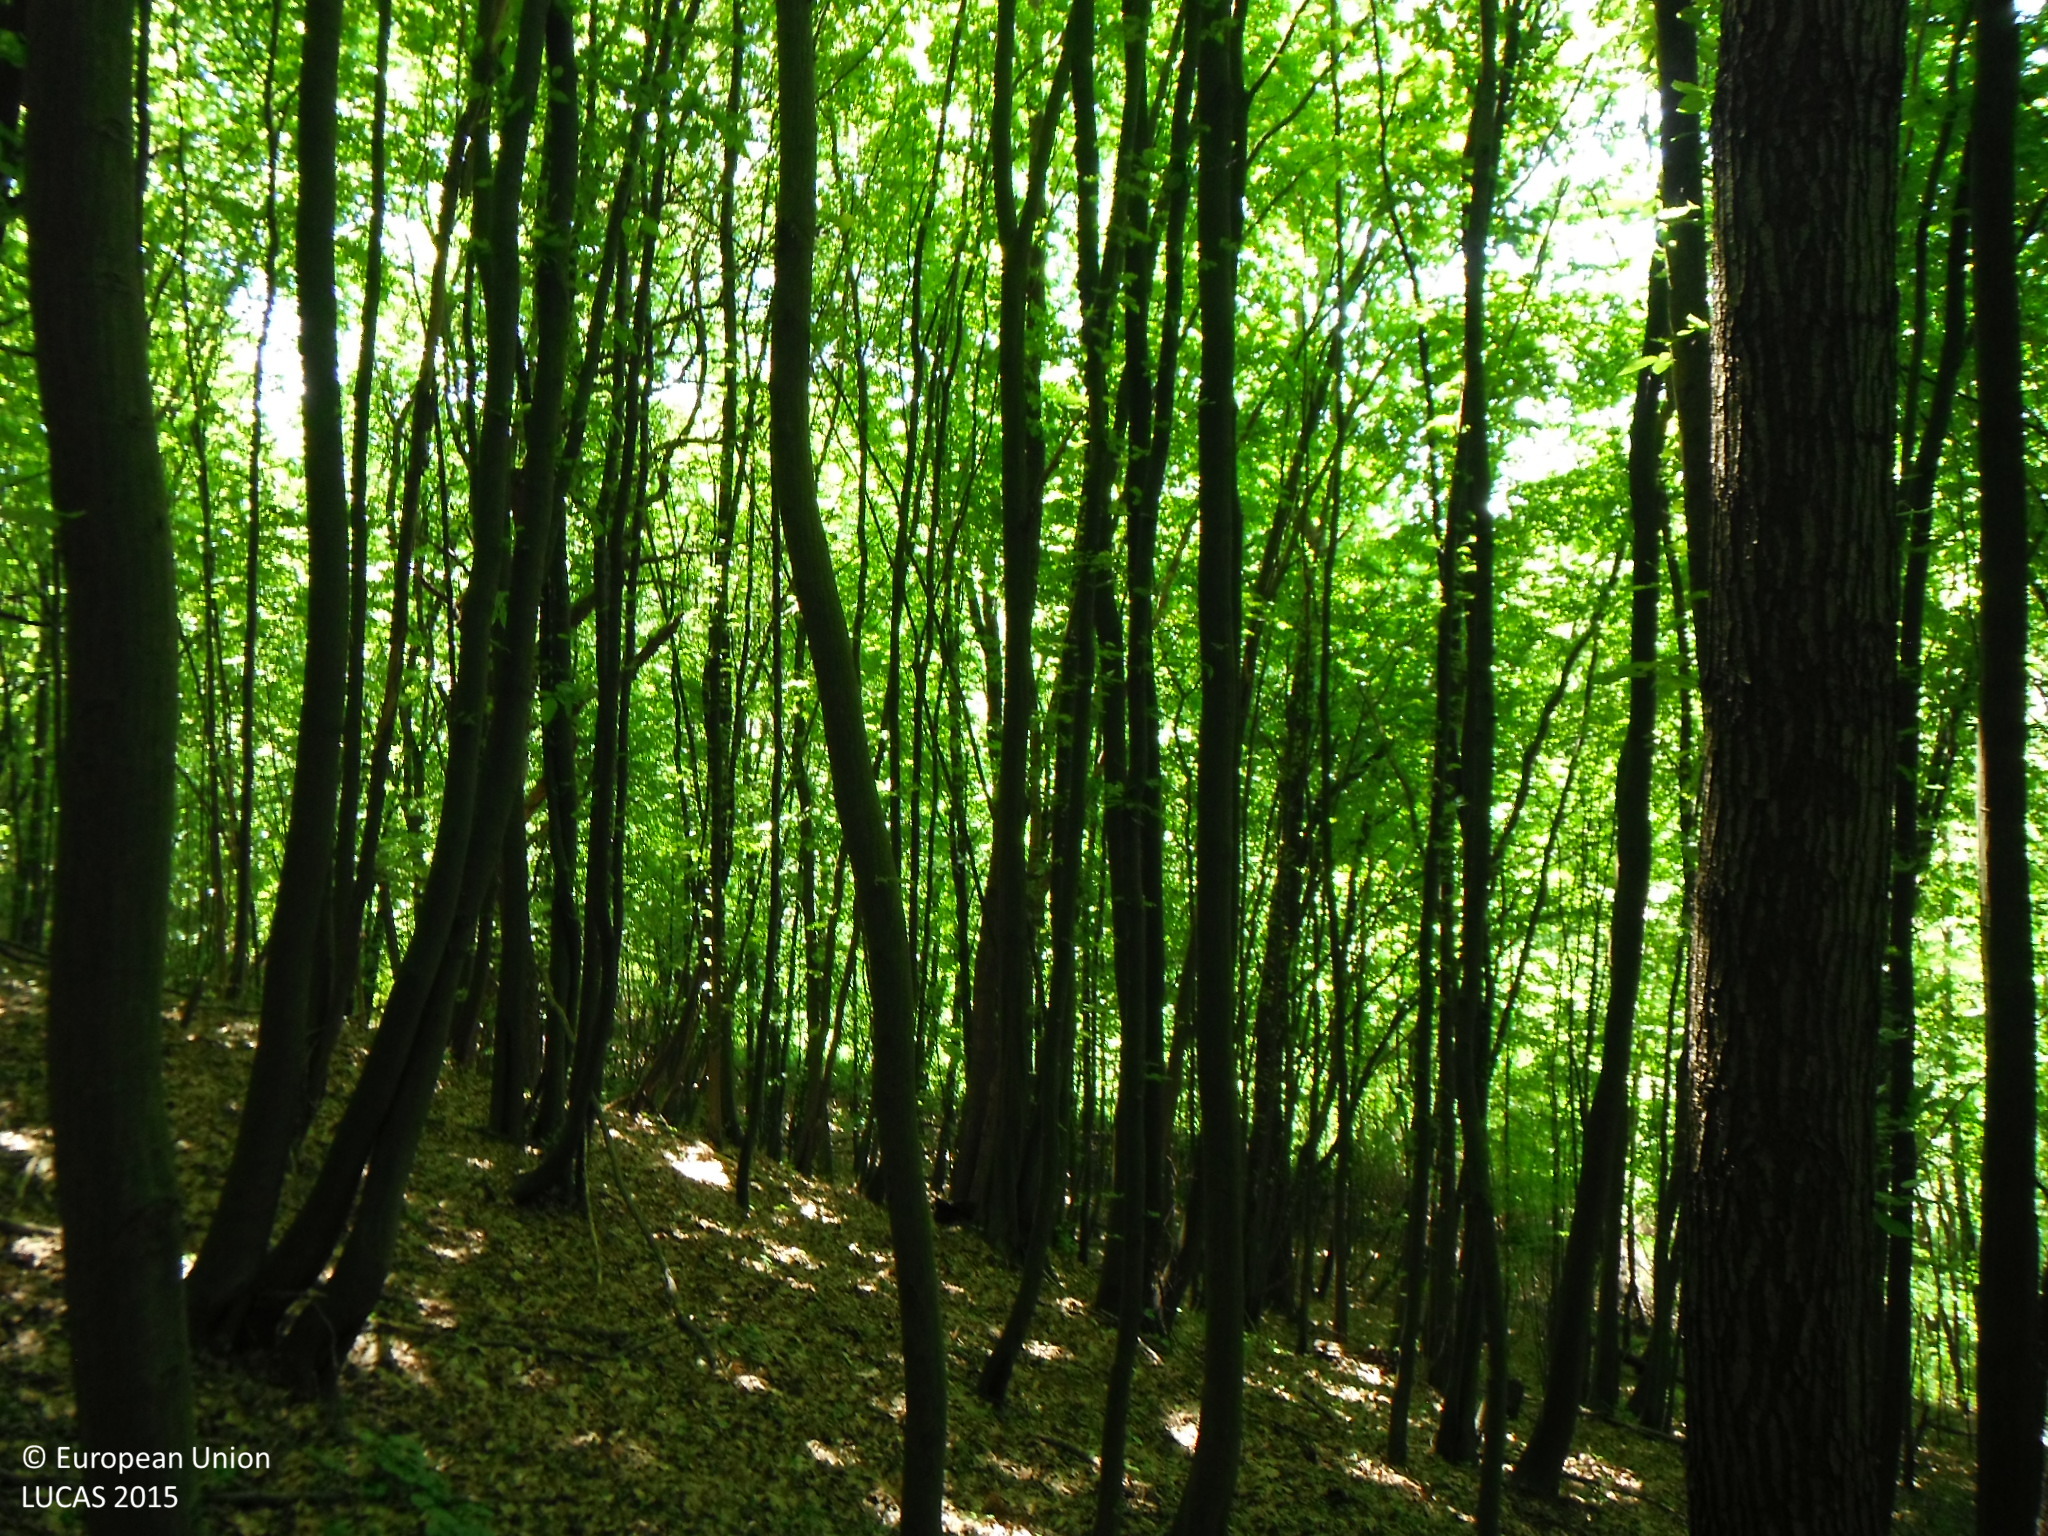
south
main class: Woodland
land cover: Broadleaved woodland
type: mesophytic deciduous forest
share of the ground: > 75 %
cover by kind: broadleaved forest trees 100 %
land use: Forestry
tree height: > 5 m
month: May
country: SK
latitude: 49.1145
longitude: 21.6272
